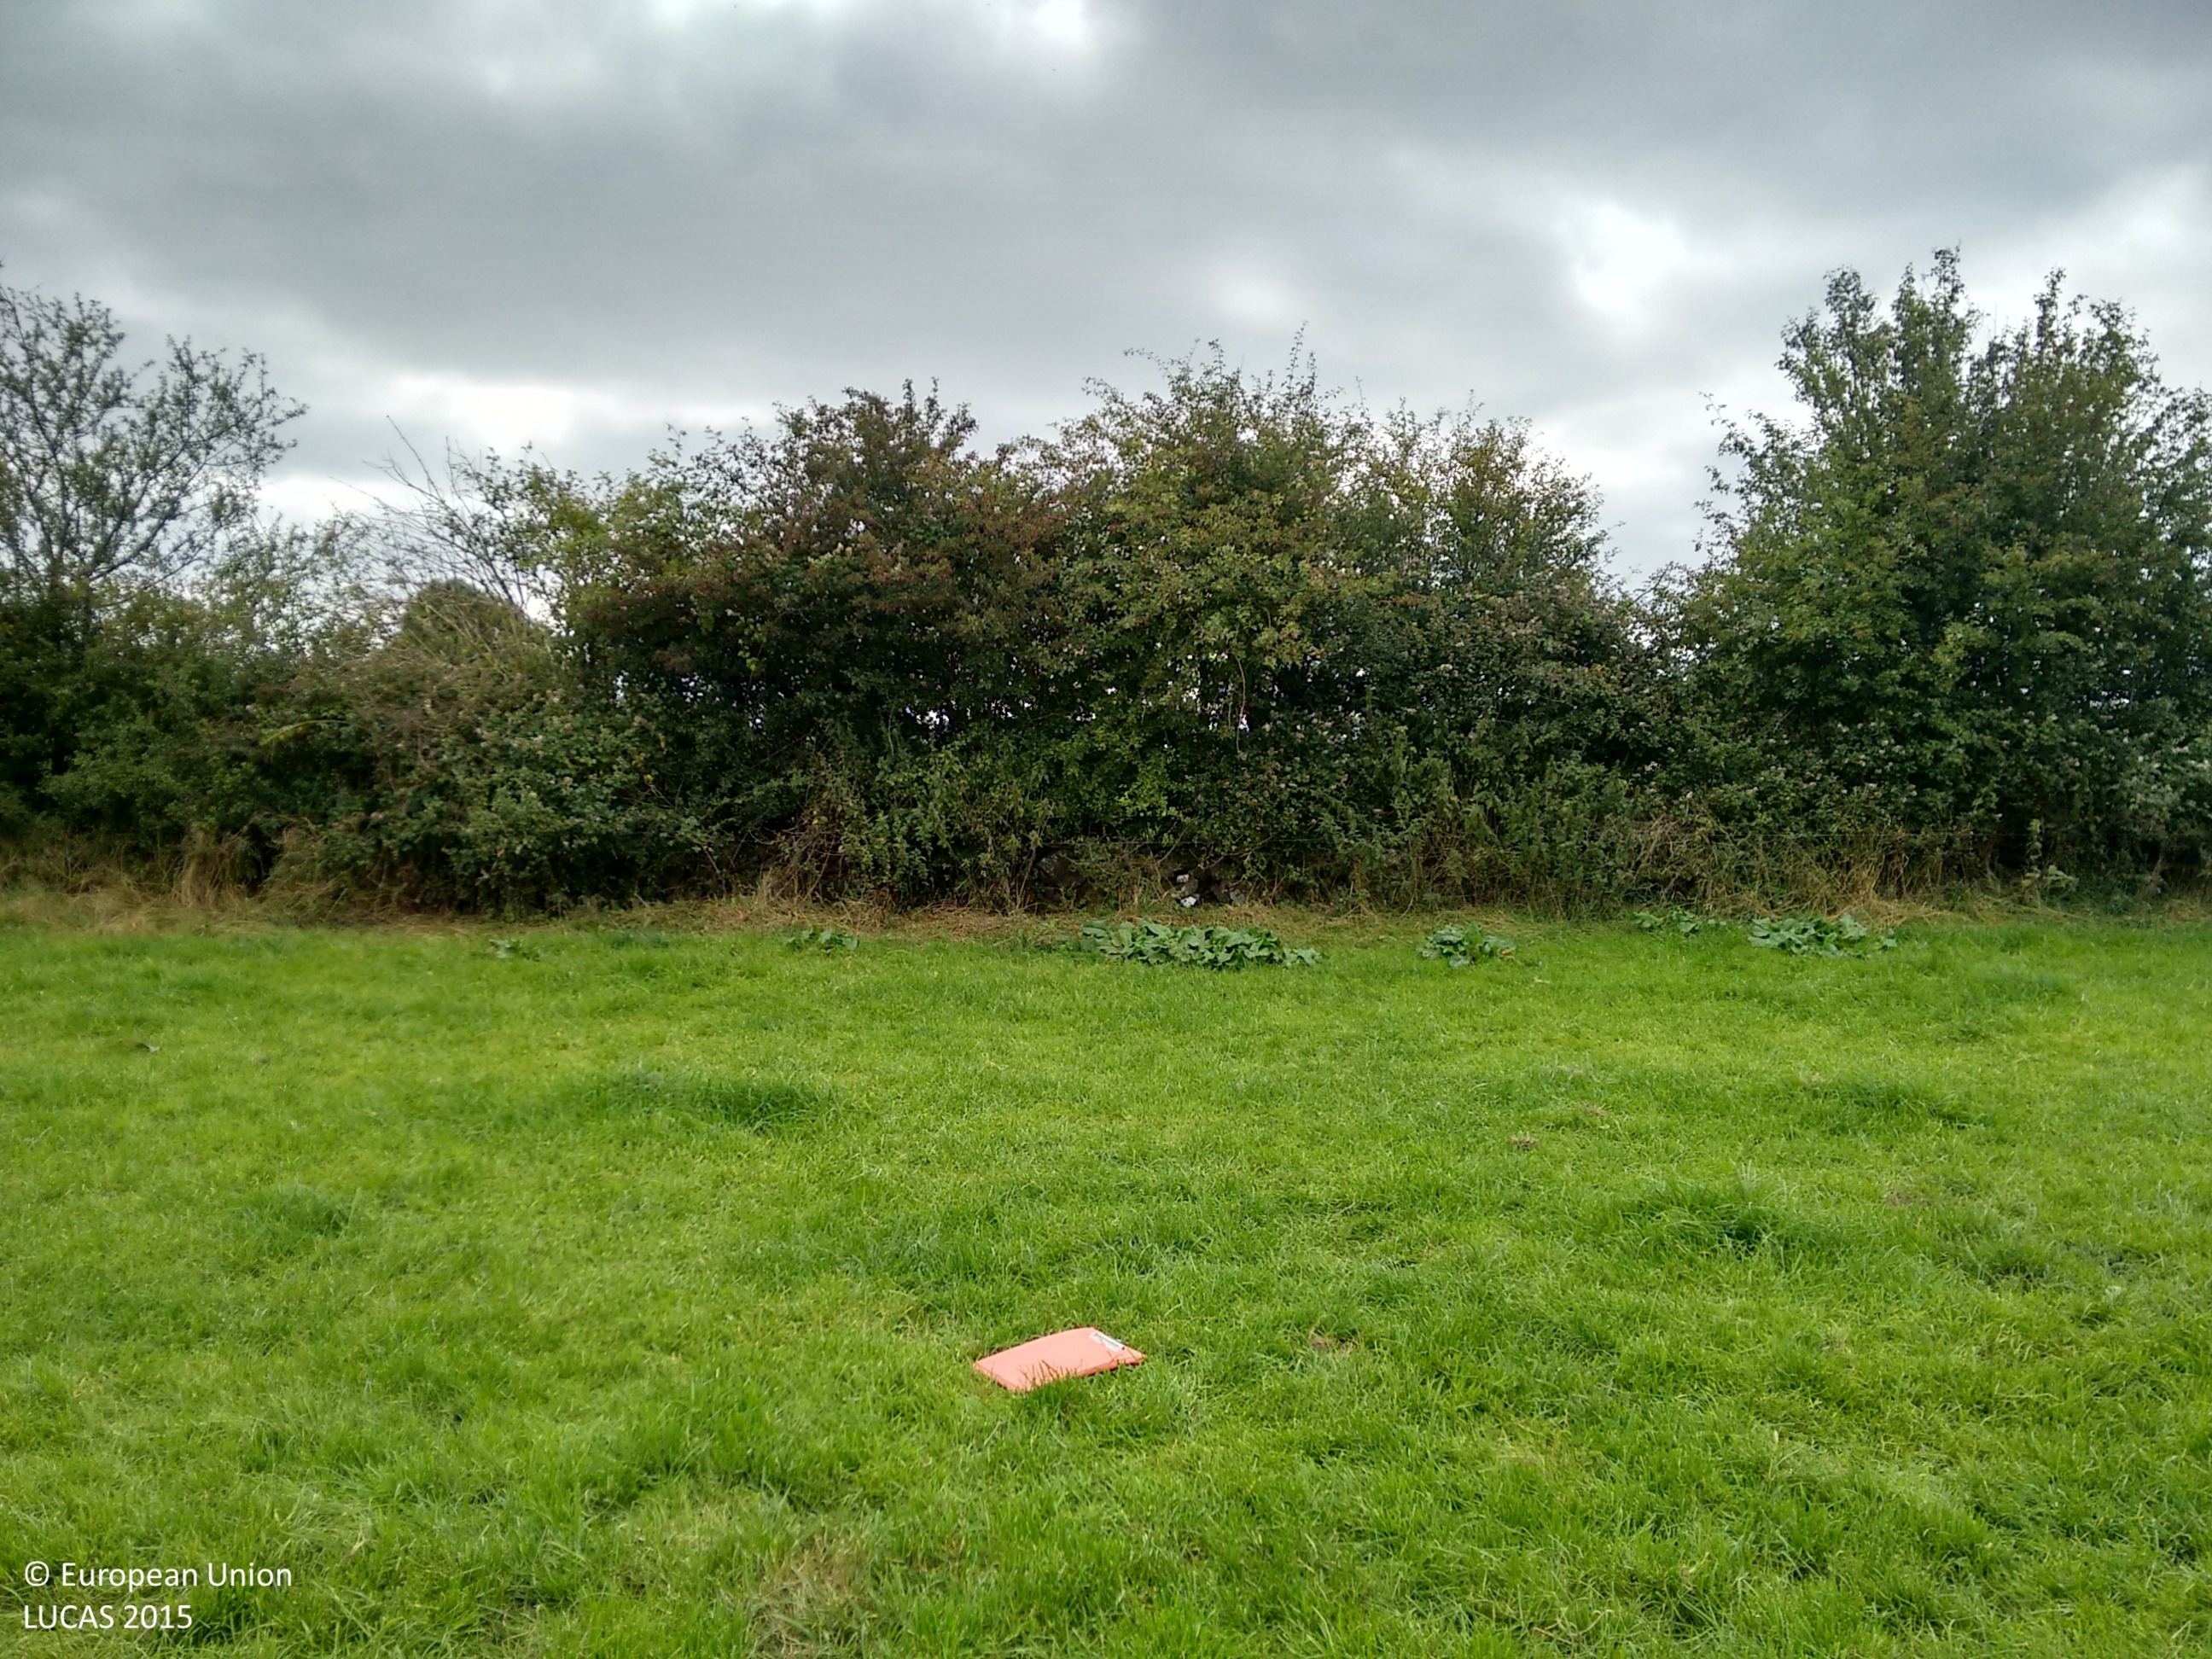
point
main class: Grassland
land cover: Grassland without tree/shrub cover
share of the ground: > 75 %
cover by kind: herbaceous plants 100 %
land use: Agriculture (excluding fallow land and kitchen gardens)
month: September
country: IE
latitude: 52.5232
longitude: -9.0049
